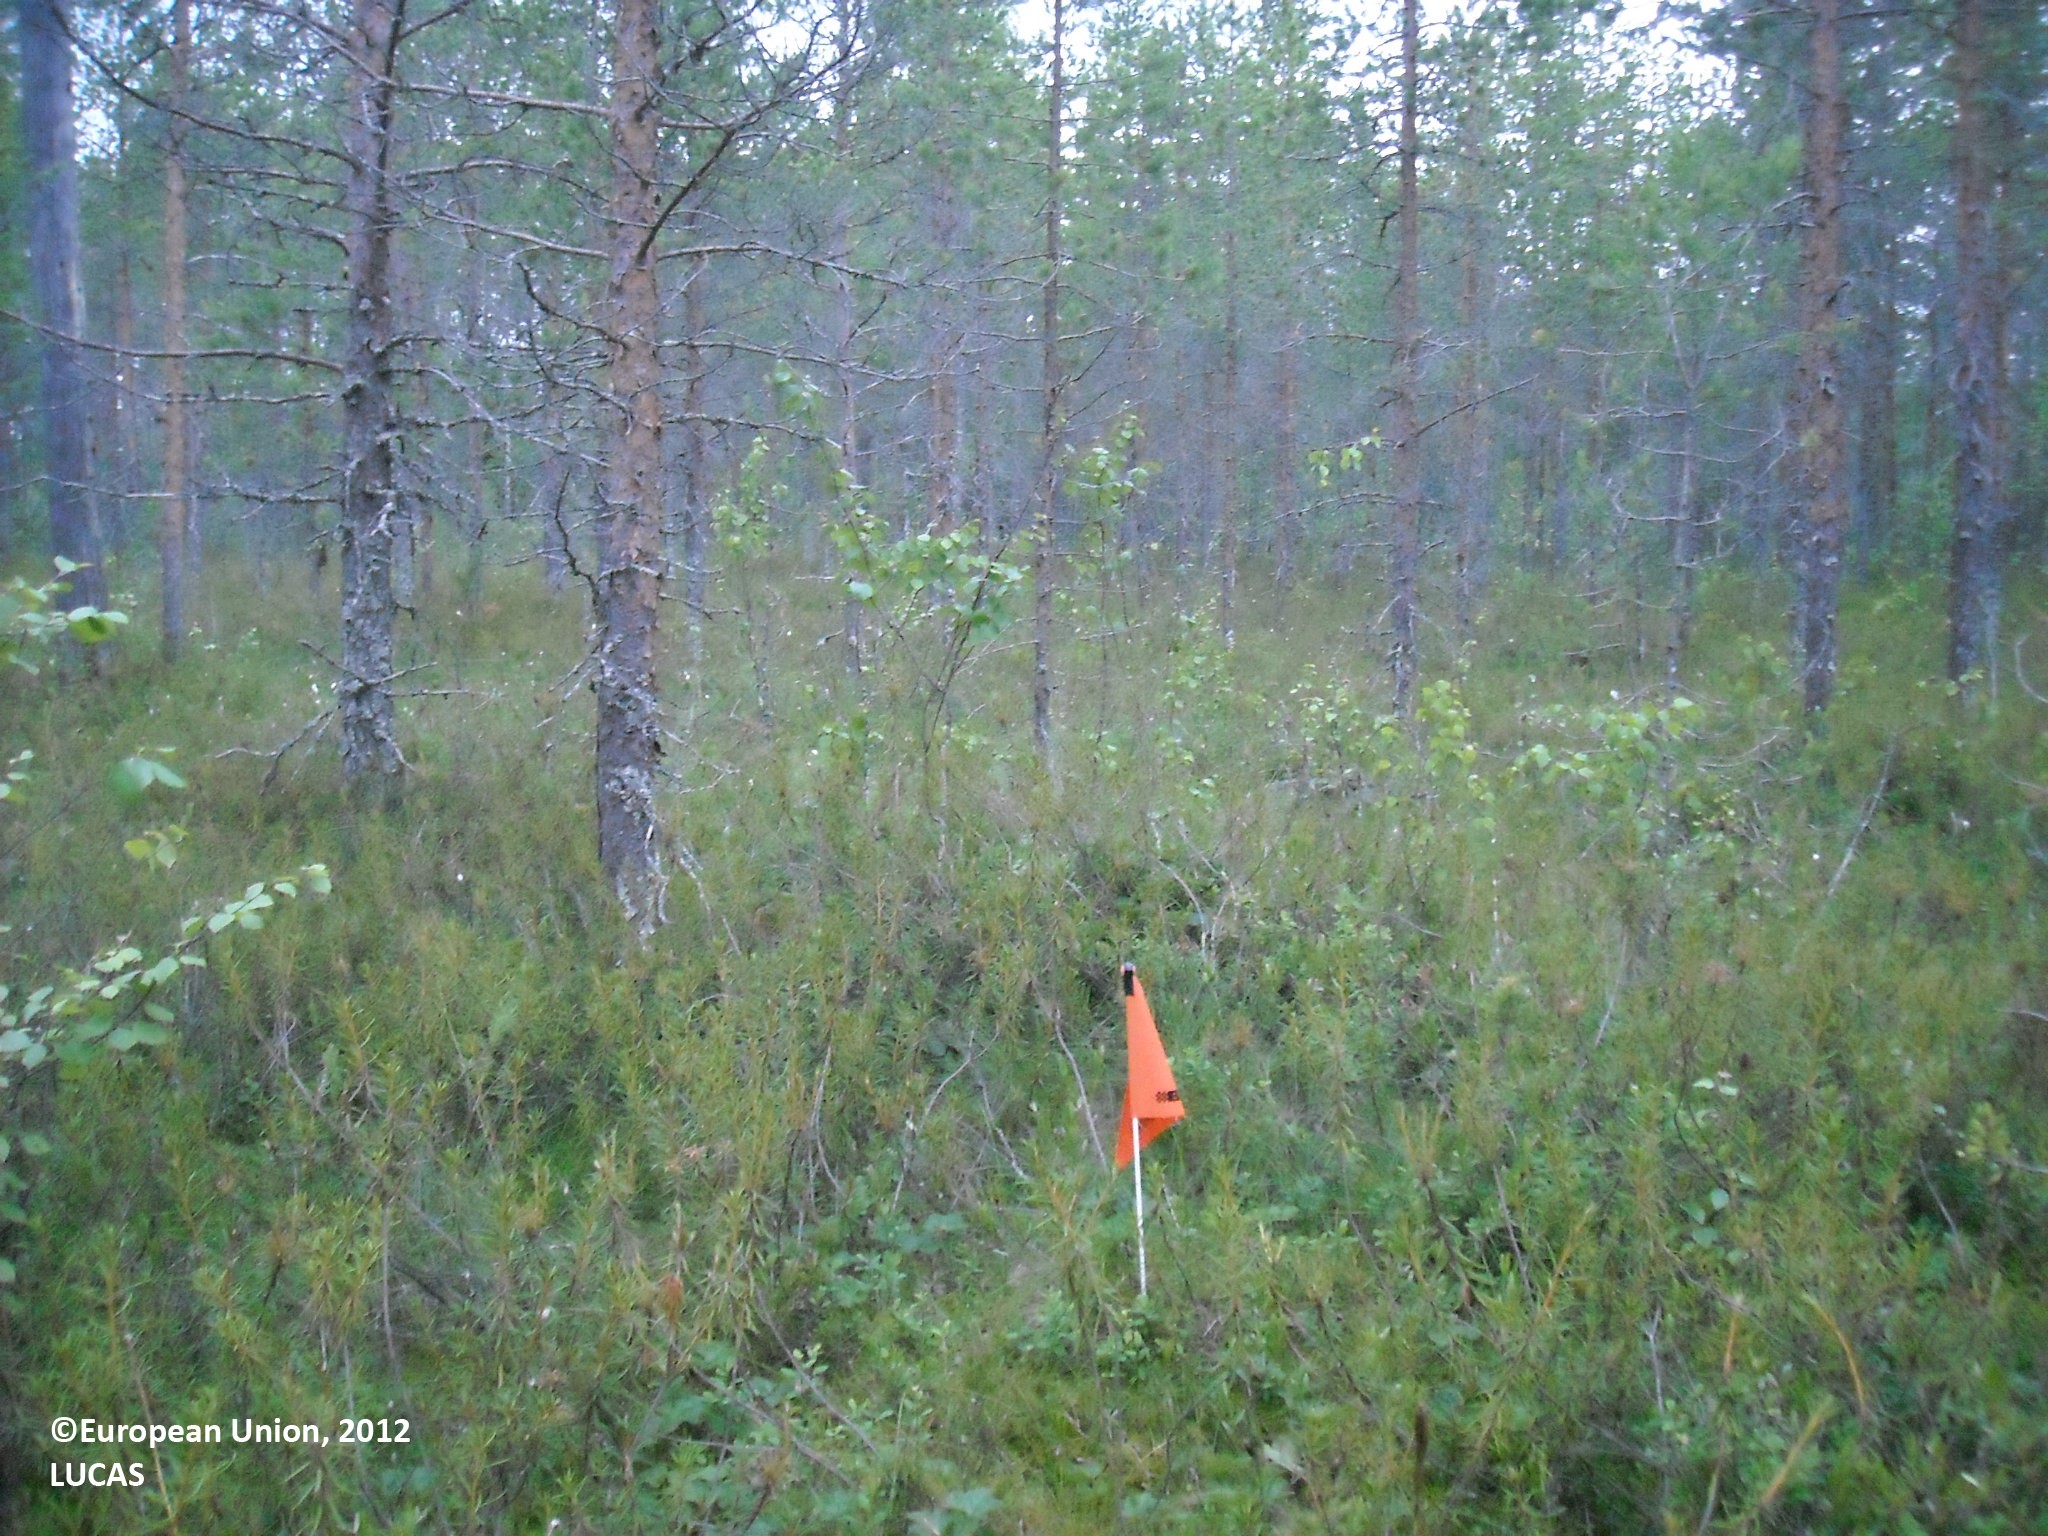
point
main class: Woodland
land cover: Pine dominated coniferous woodland
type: mire and swamp forests
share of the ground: 50 - 75 %
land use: Forestry
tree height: > 5 m
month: July
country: FI
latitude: 65.0354
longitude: 26.7845
